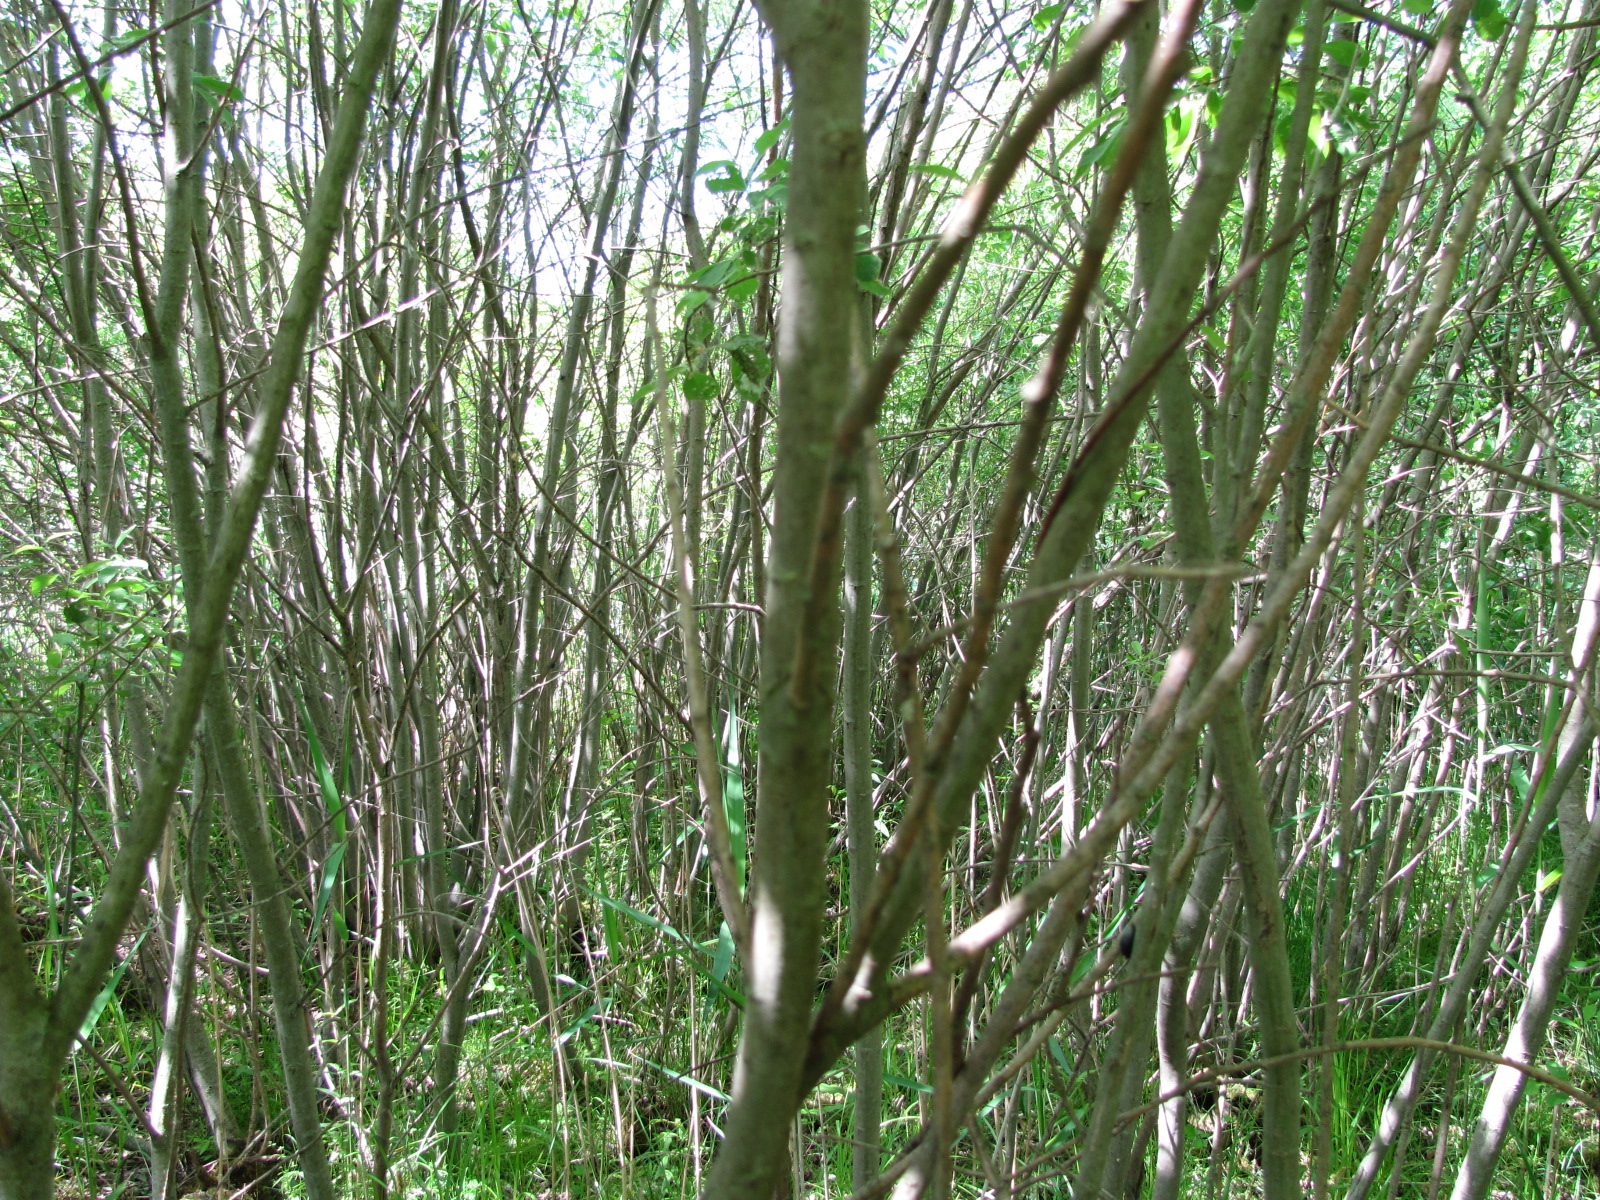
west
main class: Shrubland
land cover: Shrubland without tree cover
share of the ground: > 75 %
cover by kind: shrubs 100 %
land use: Semi-natural and natural areas not in use
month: June
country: LV
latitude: 56.2788
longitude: 24.1243
